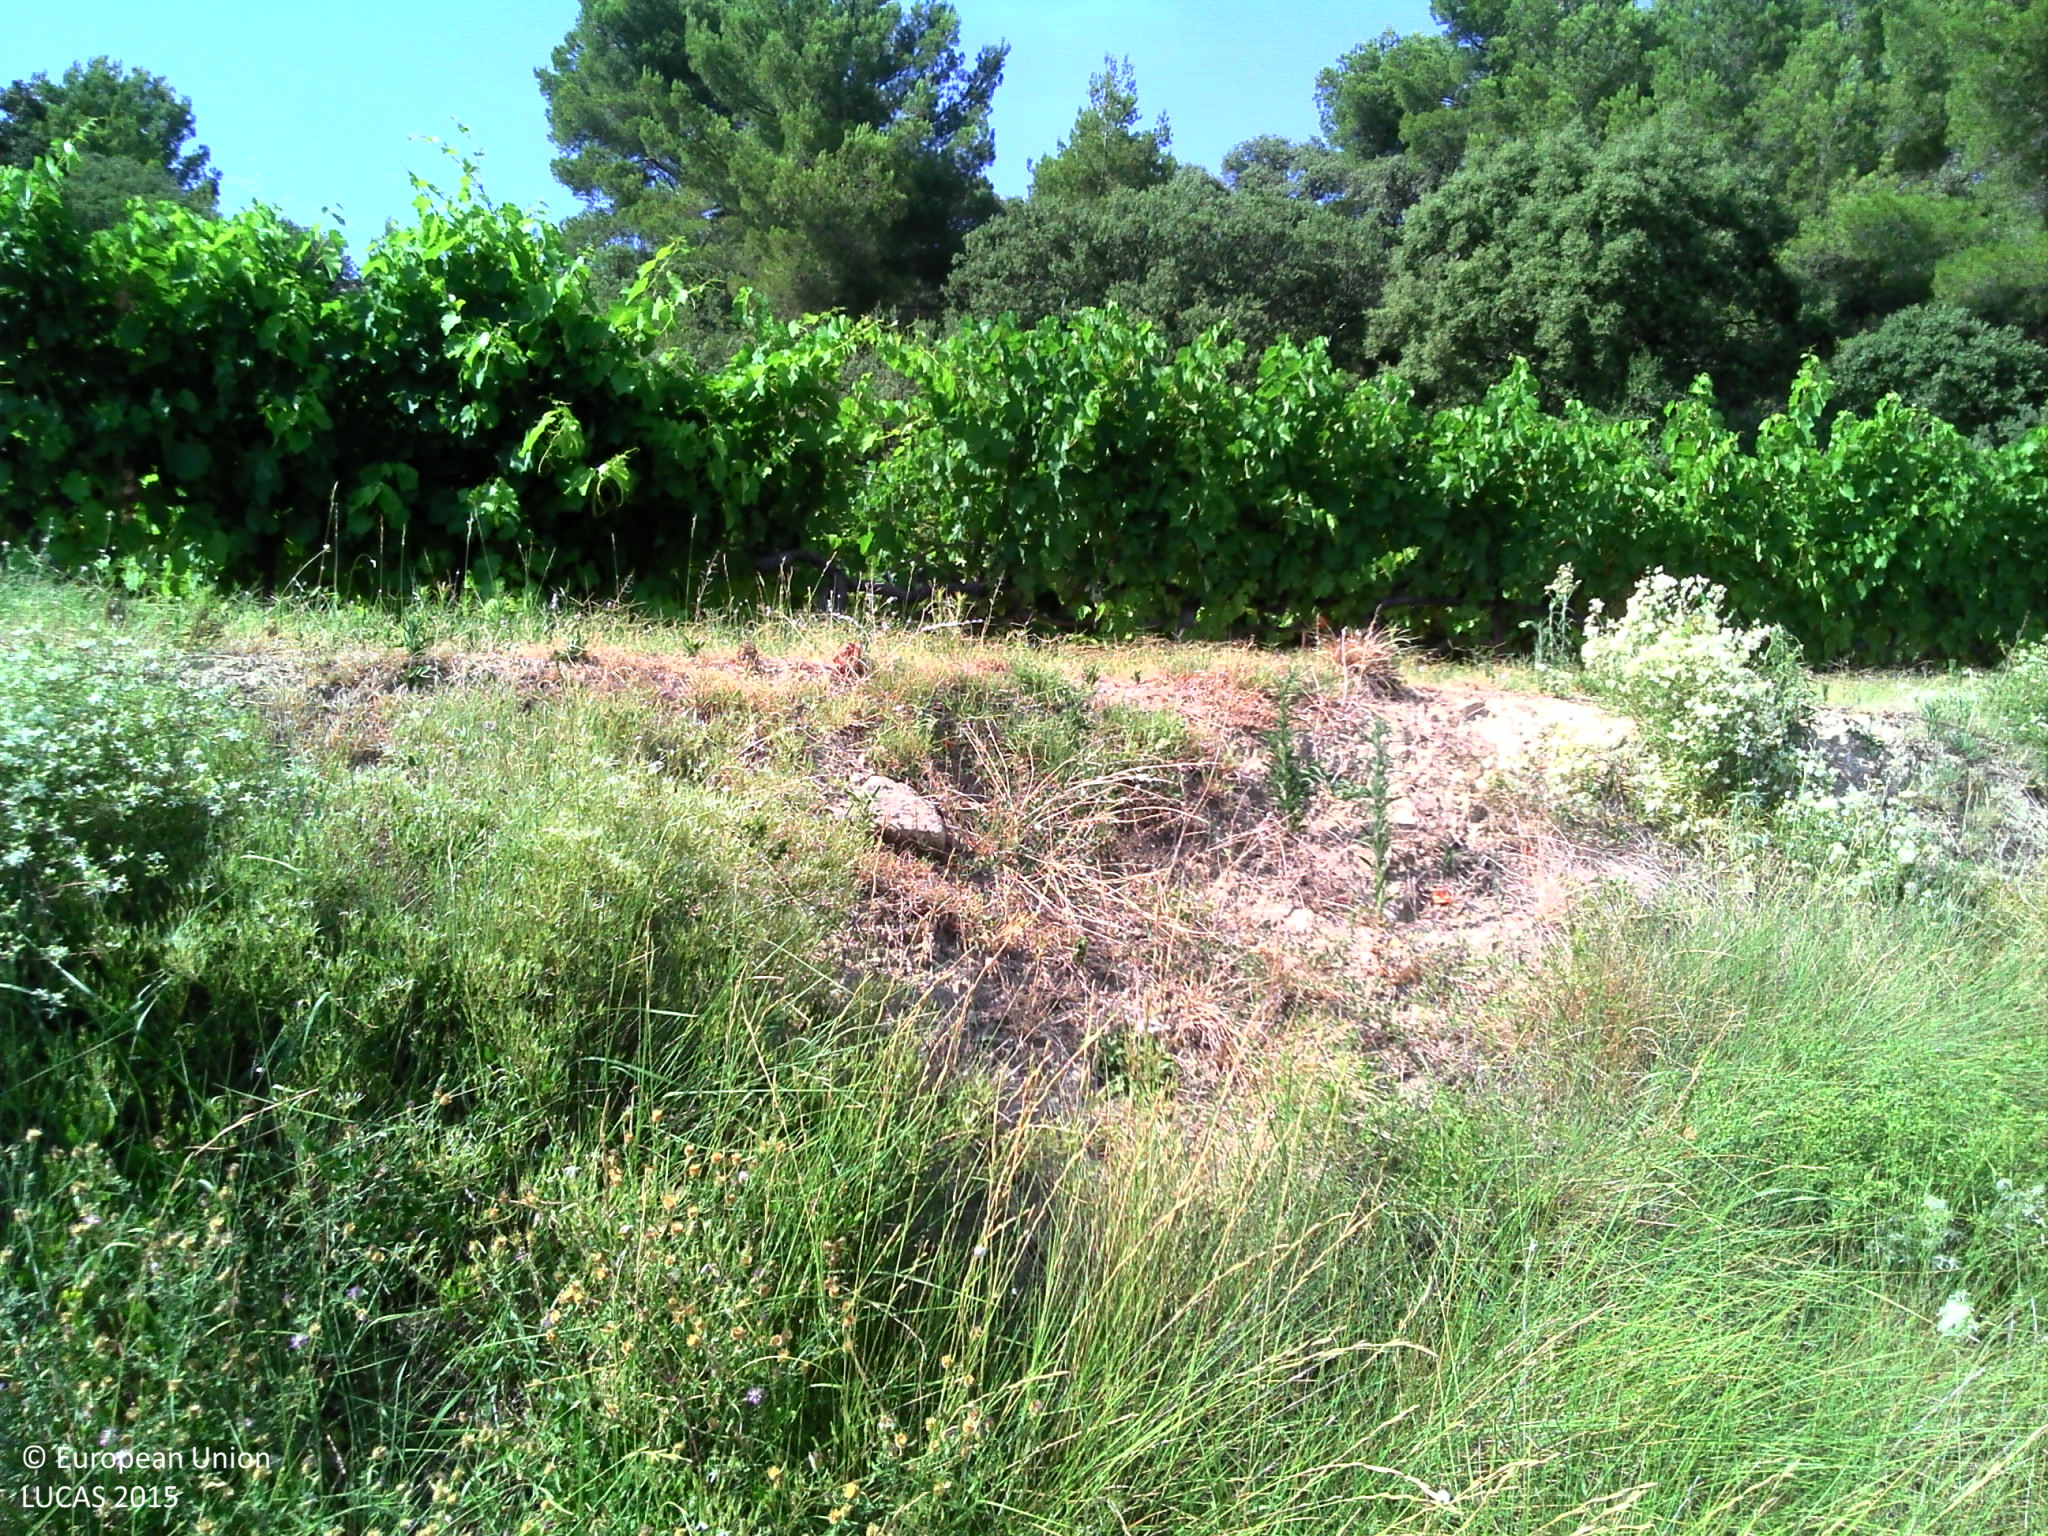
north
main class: Grassland
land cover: Grassland without tree/shrub cover
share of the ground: > 75 %
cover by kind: herbaceous plants 80 %, unconsolidated bare surface 20 %
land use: Agriculture (excluding fallow land and kitchen gardens)
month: July
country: FR
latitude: 44.1251
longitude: 5.0717
